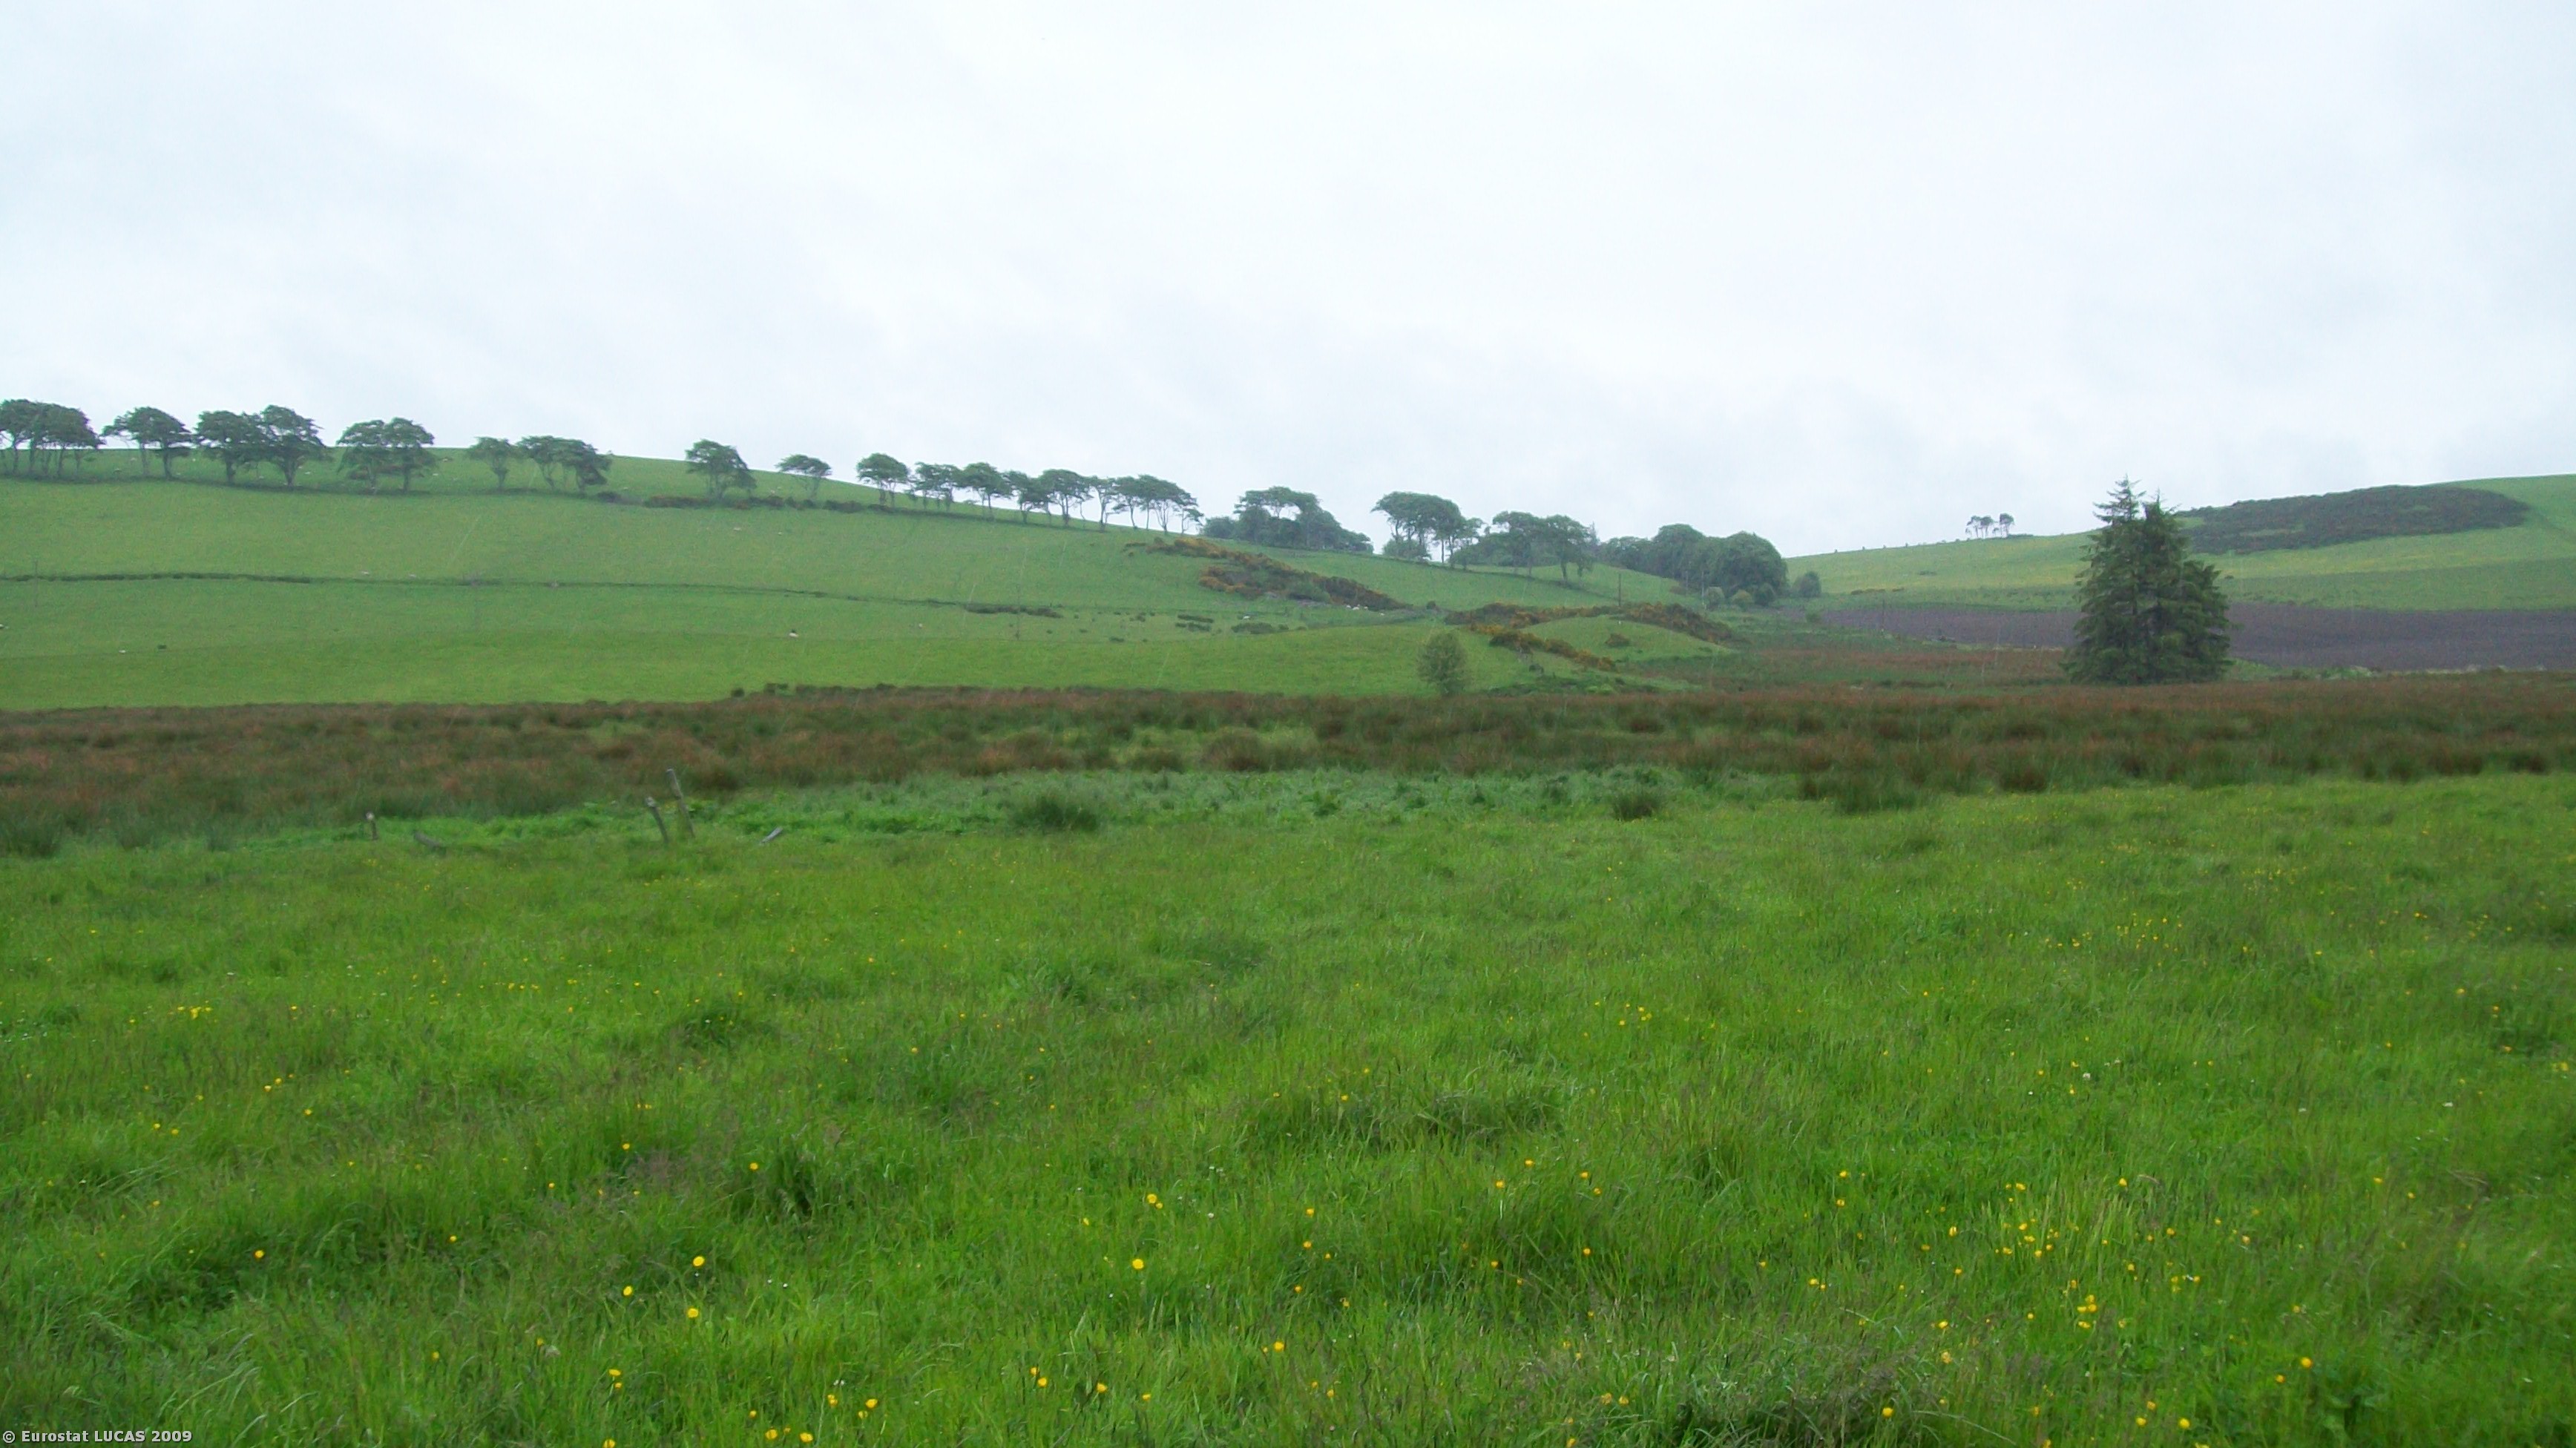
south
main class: Grassland
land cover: Grassland without tree/shrub cover
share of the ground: > 75 %
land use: Agriculture (excluding fallow land and kitchen gardens)
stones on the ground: 10 - 25 %
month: June
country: GB
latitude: 57.5887
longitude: -2.5828
